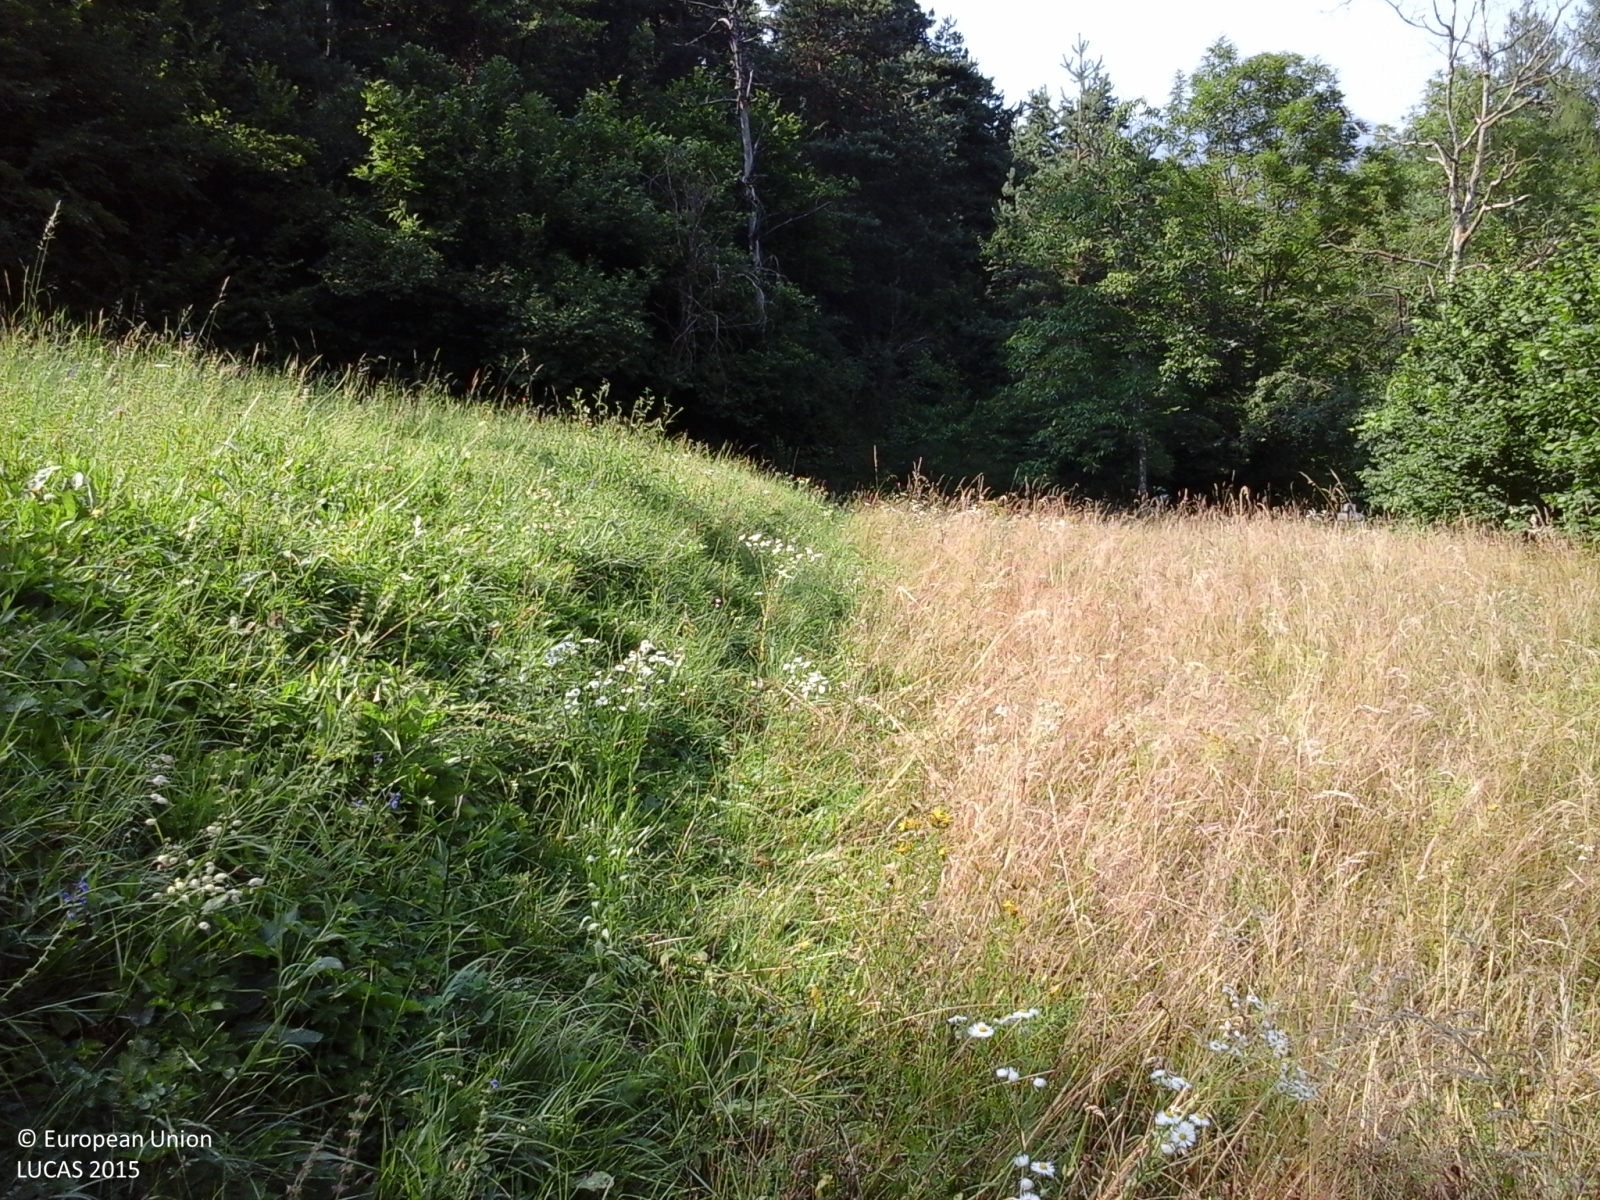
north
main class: Grassland
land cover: Grassland with sparse tree/shrub cover
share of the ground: > 75 %
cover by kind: herbaceous plants 95 %, broadleaved forest trees 5 %
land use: Agriculture (excluding fallow land and kitchen gardens)
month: July
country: IT
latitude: 44.4599
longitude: 7.3032
